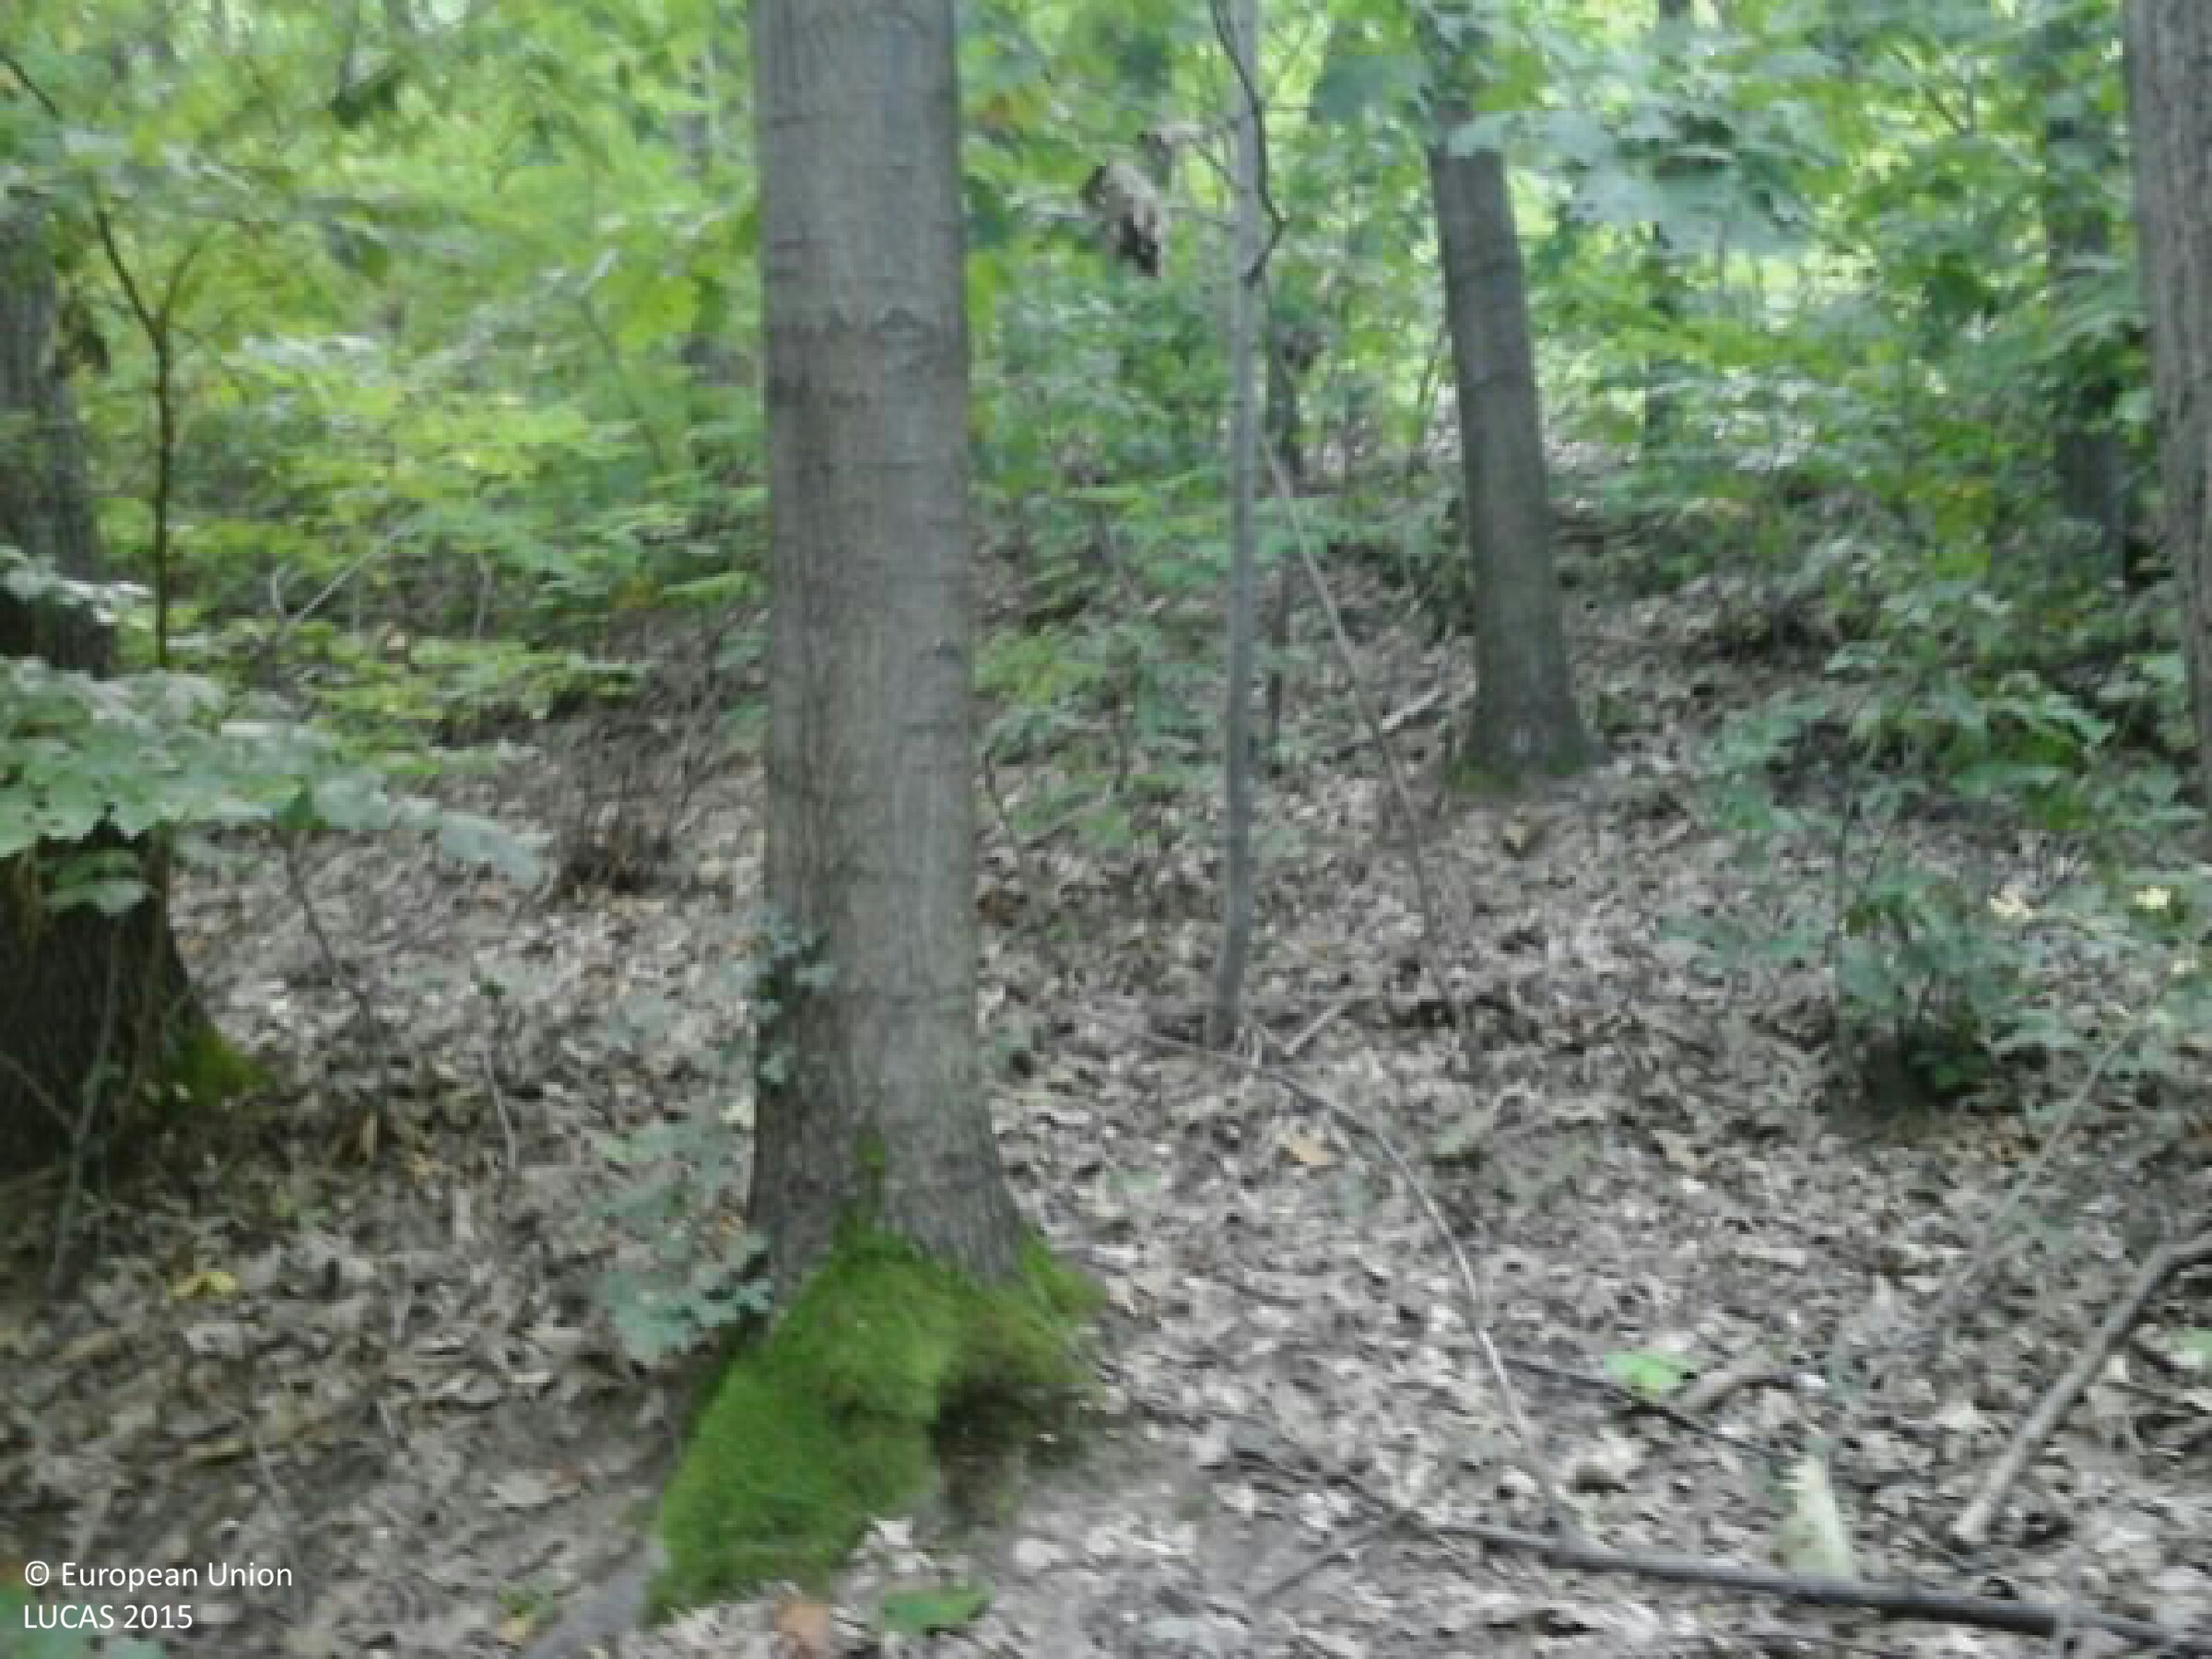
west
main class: Woodland
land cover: Broadleaved woodland
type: mesophytic deciduous forest
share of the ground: > 75 %
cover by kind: broadleaved forest trees 100 %
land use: Forestry
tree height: > 5 m
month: September
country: HU
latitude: 48.1438
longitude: 19.8516
